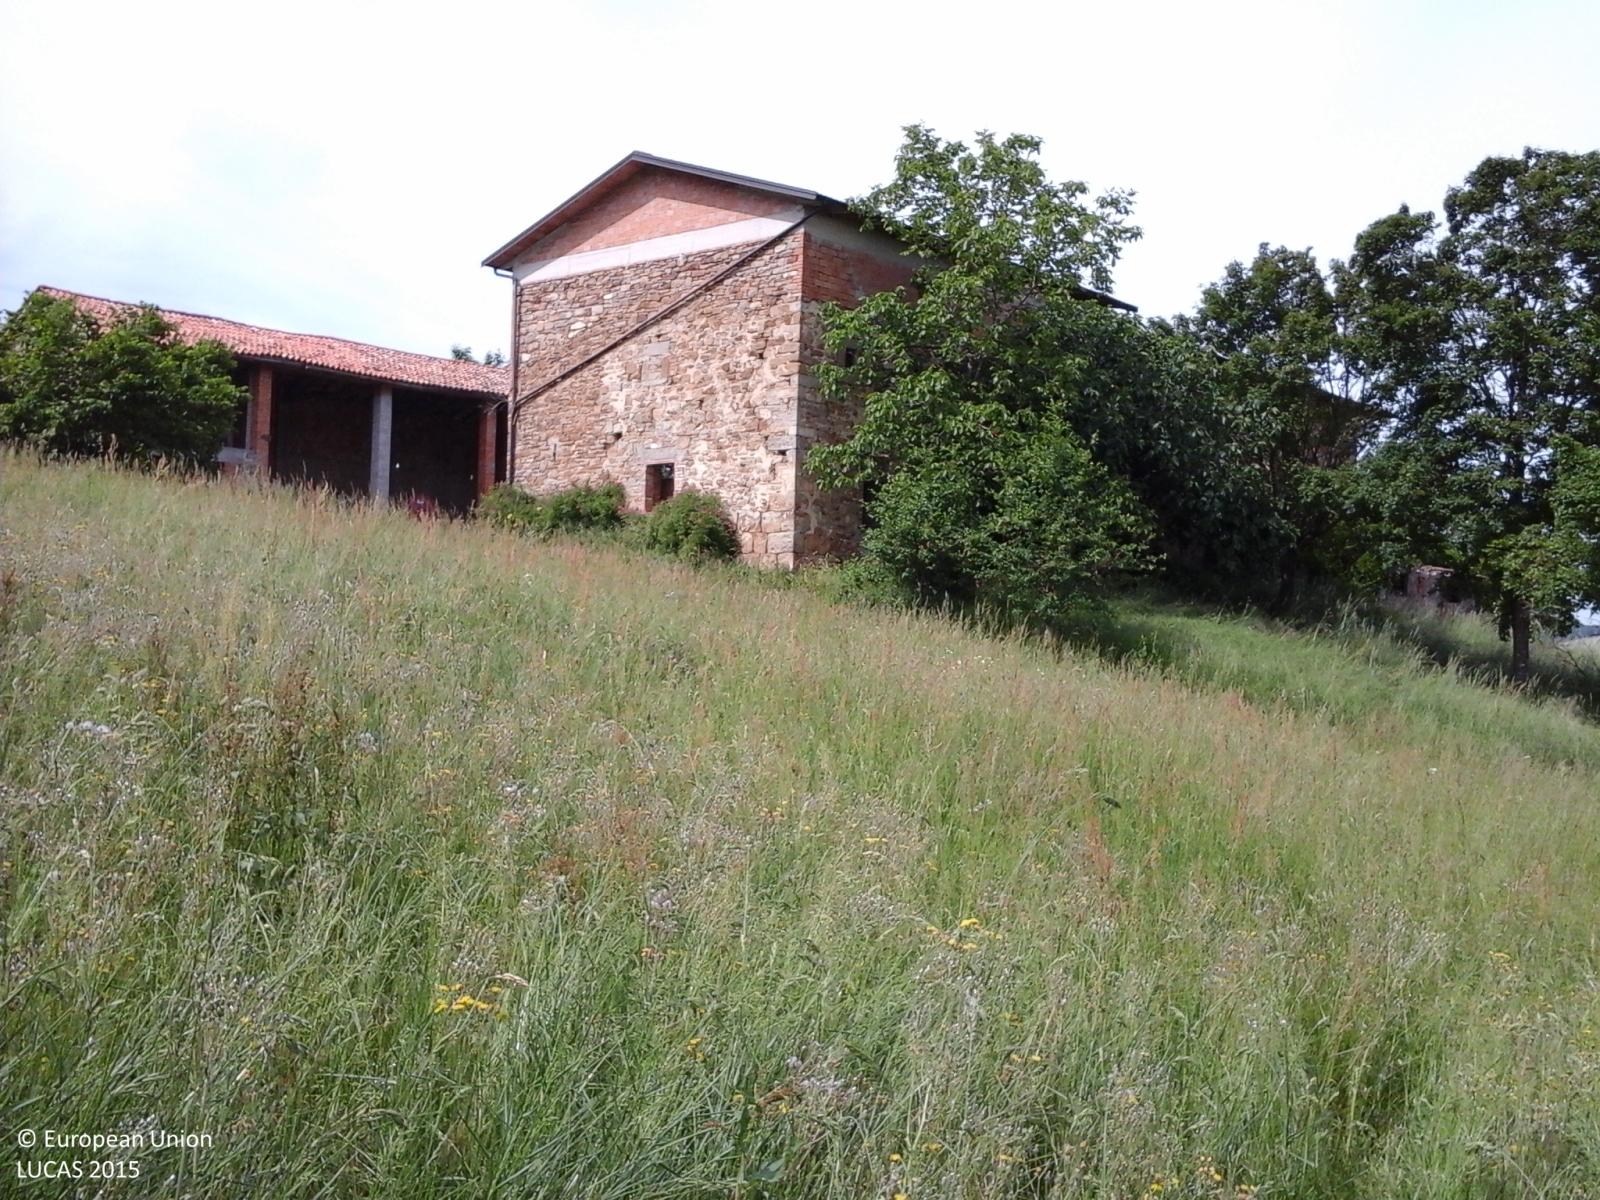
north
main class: Grassland
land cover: Spontaneously vegetated surfaces
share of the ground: > 75 %
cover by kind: herbaceous plants 100 %
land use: Agriculture (excluding fallow land and kitchen gardens)
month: May
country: IT
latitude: 44.3479
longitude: 10.7384
